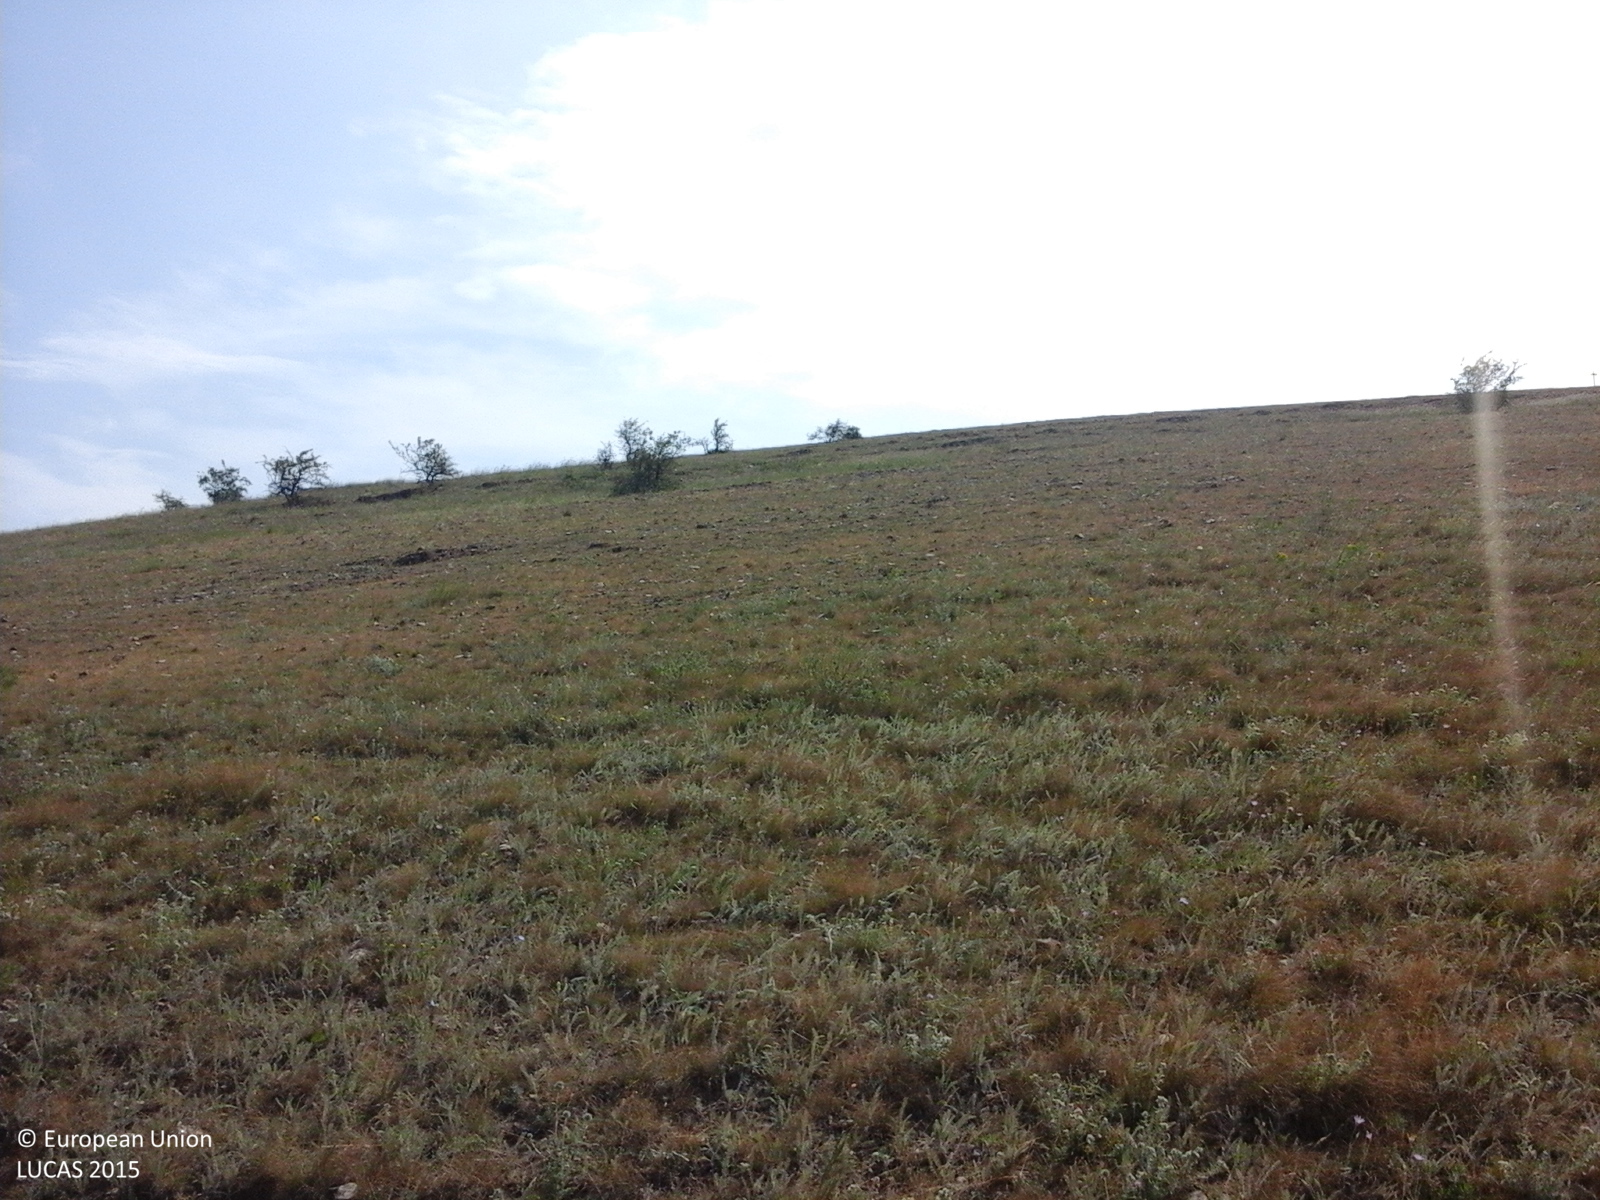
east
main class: Grassland
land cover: Grassland with sparse tree/shrub cover
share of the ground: > 75 %
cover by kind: herbaceous plants 85 %, shrubs 10 %, broadleaved forest trees 5 %
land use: Agriculture (excluding fallow land and kitchen gardens)
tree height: < 5 m
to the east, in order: Grassland with sparse tree/shrub cover; Grassland without tree/shrub cover; Rocks and stones; Grassland with sparse tree/shrub cover
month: August
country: RO
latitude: 45.0614
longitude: 28.9528
